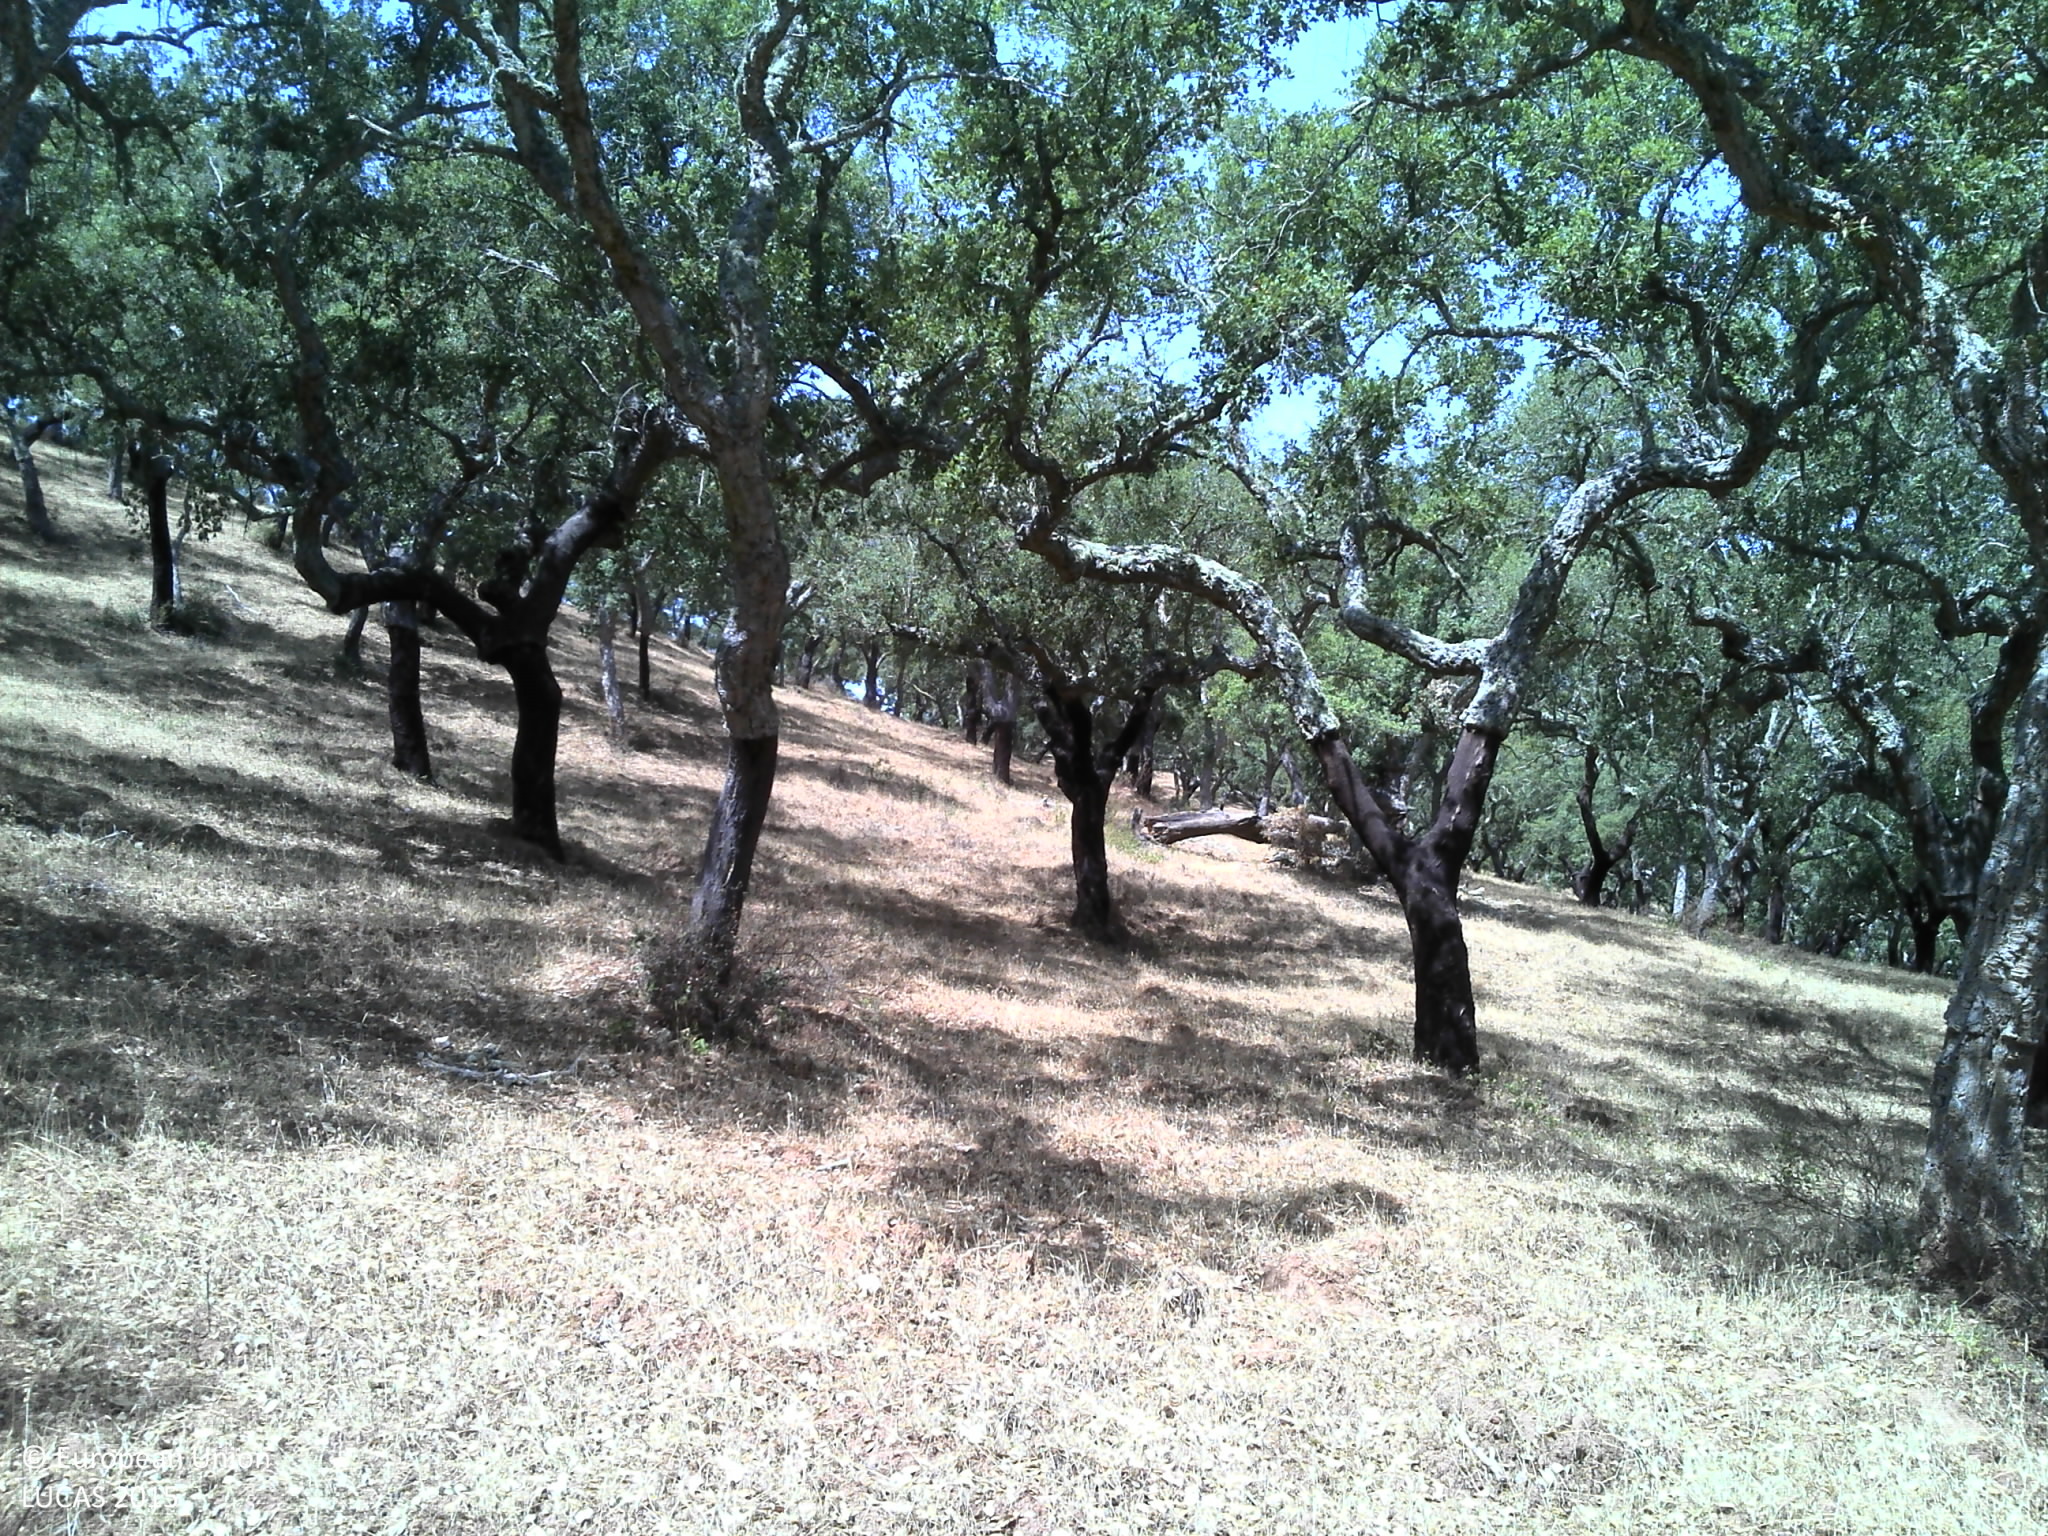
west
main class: Woodland
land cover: Broadleaved woodland
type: broadleaved evergreen forest
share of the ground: > 75 %
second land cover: Grassland without tree/shrub cover
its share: 25 - 50 %
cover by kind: broadleaved forest trees 75 %, herbaceous plants 20 %, shrubs 5 %
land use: Forestry
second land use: Agriculture (excluding fallow land and kitchen gardens)
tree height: > 5 m
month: July
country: PT
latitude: 38.2633
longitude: -7.7564
